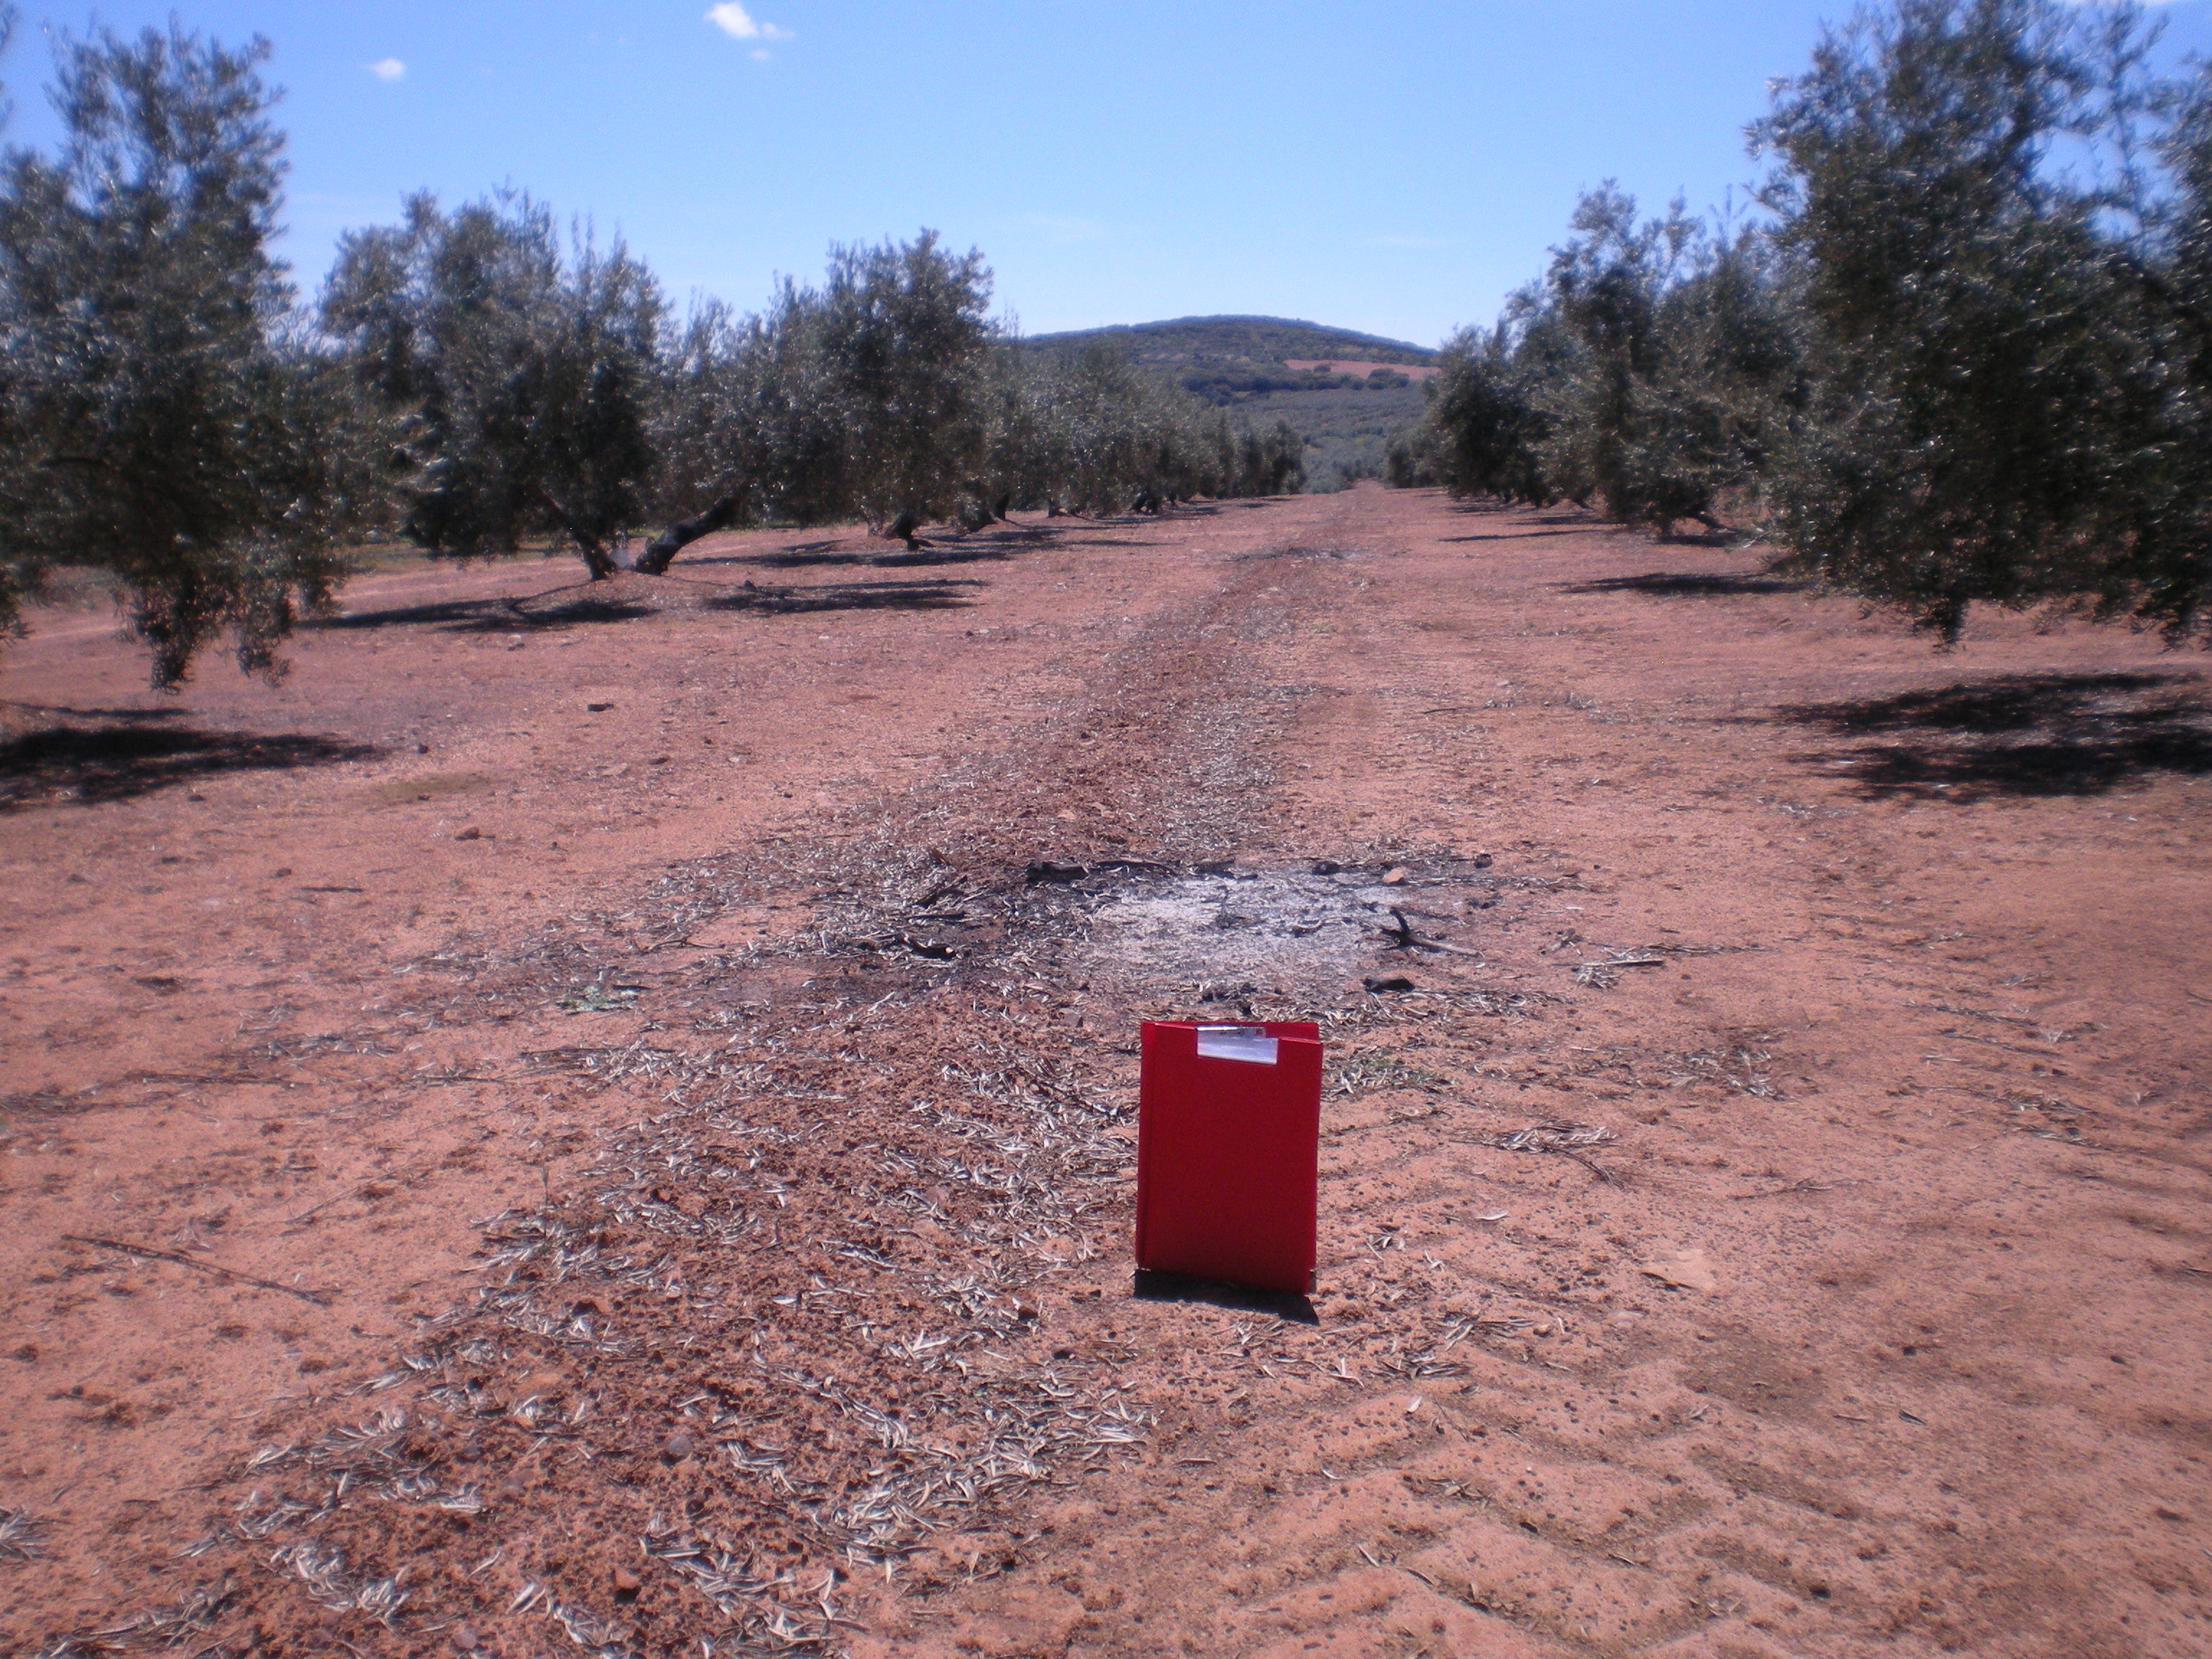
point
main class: Cropland
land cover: Olive groves
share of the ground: 25 - 50 %
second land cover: Other bare soil
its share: > 75 %
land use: Agriculture (excluding fallow land and kitchen gardens)
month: April
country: ES
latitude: 38.5436
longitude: -2.9570
